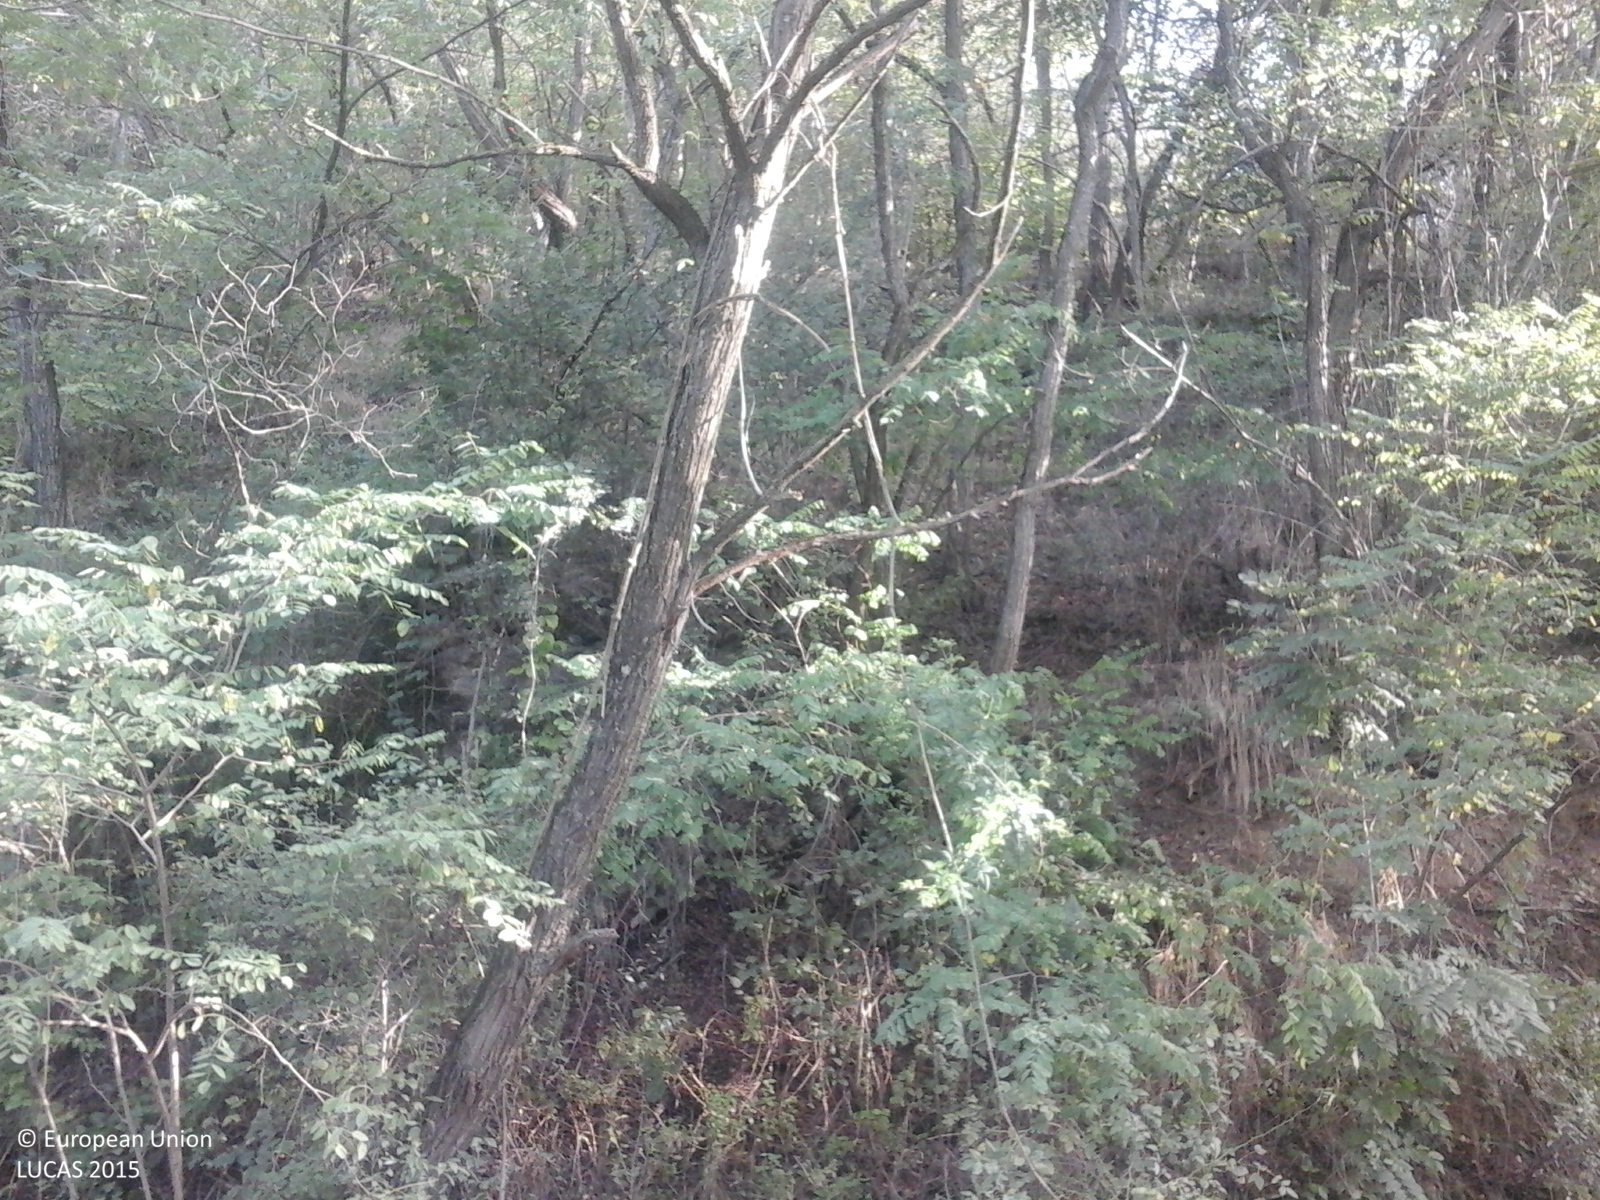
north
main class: Woodland
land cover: Broadleaved woodland
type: beech forest
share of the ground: > 75 %
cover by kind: broadleaved forest trees 100 %
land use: Forestry
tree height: > 5 m
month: September
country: RO
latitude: 46.7356
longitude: 23.3231
